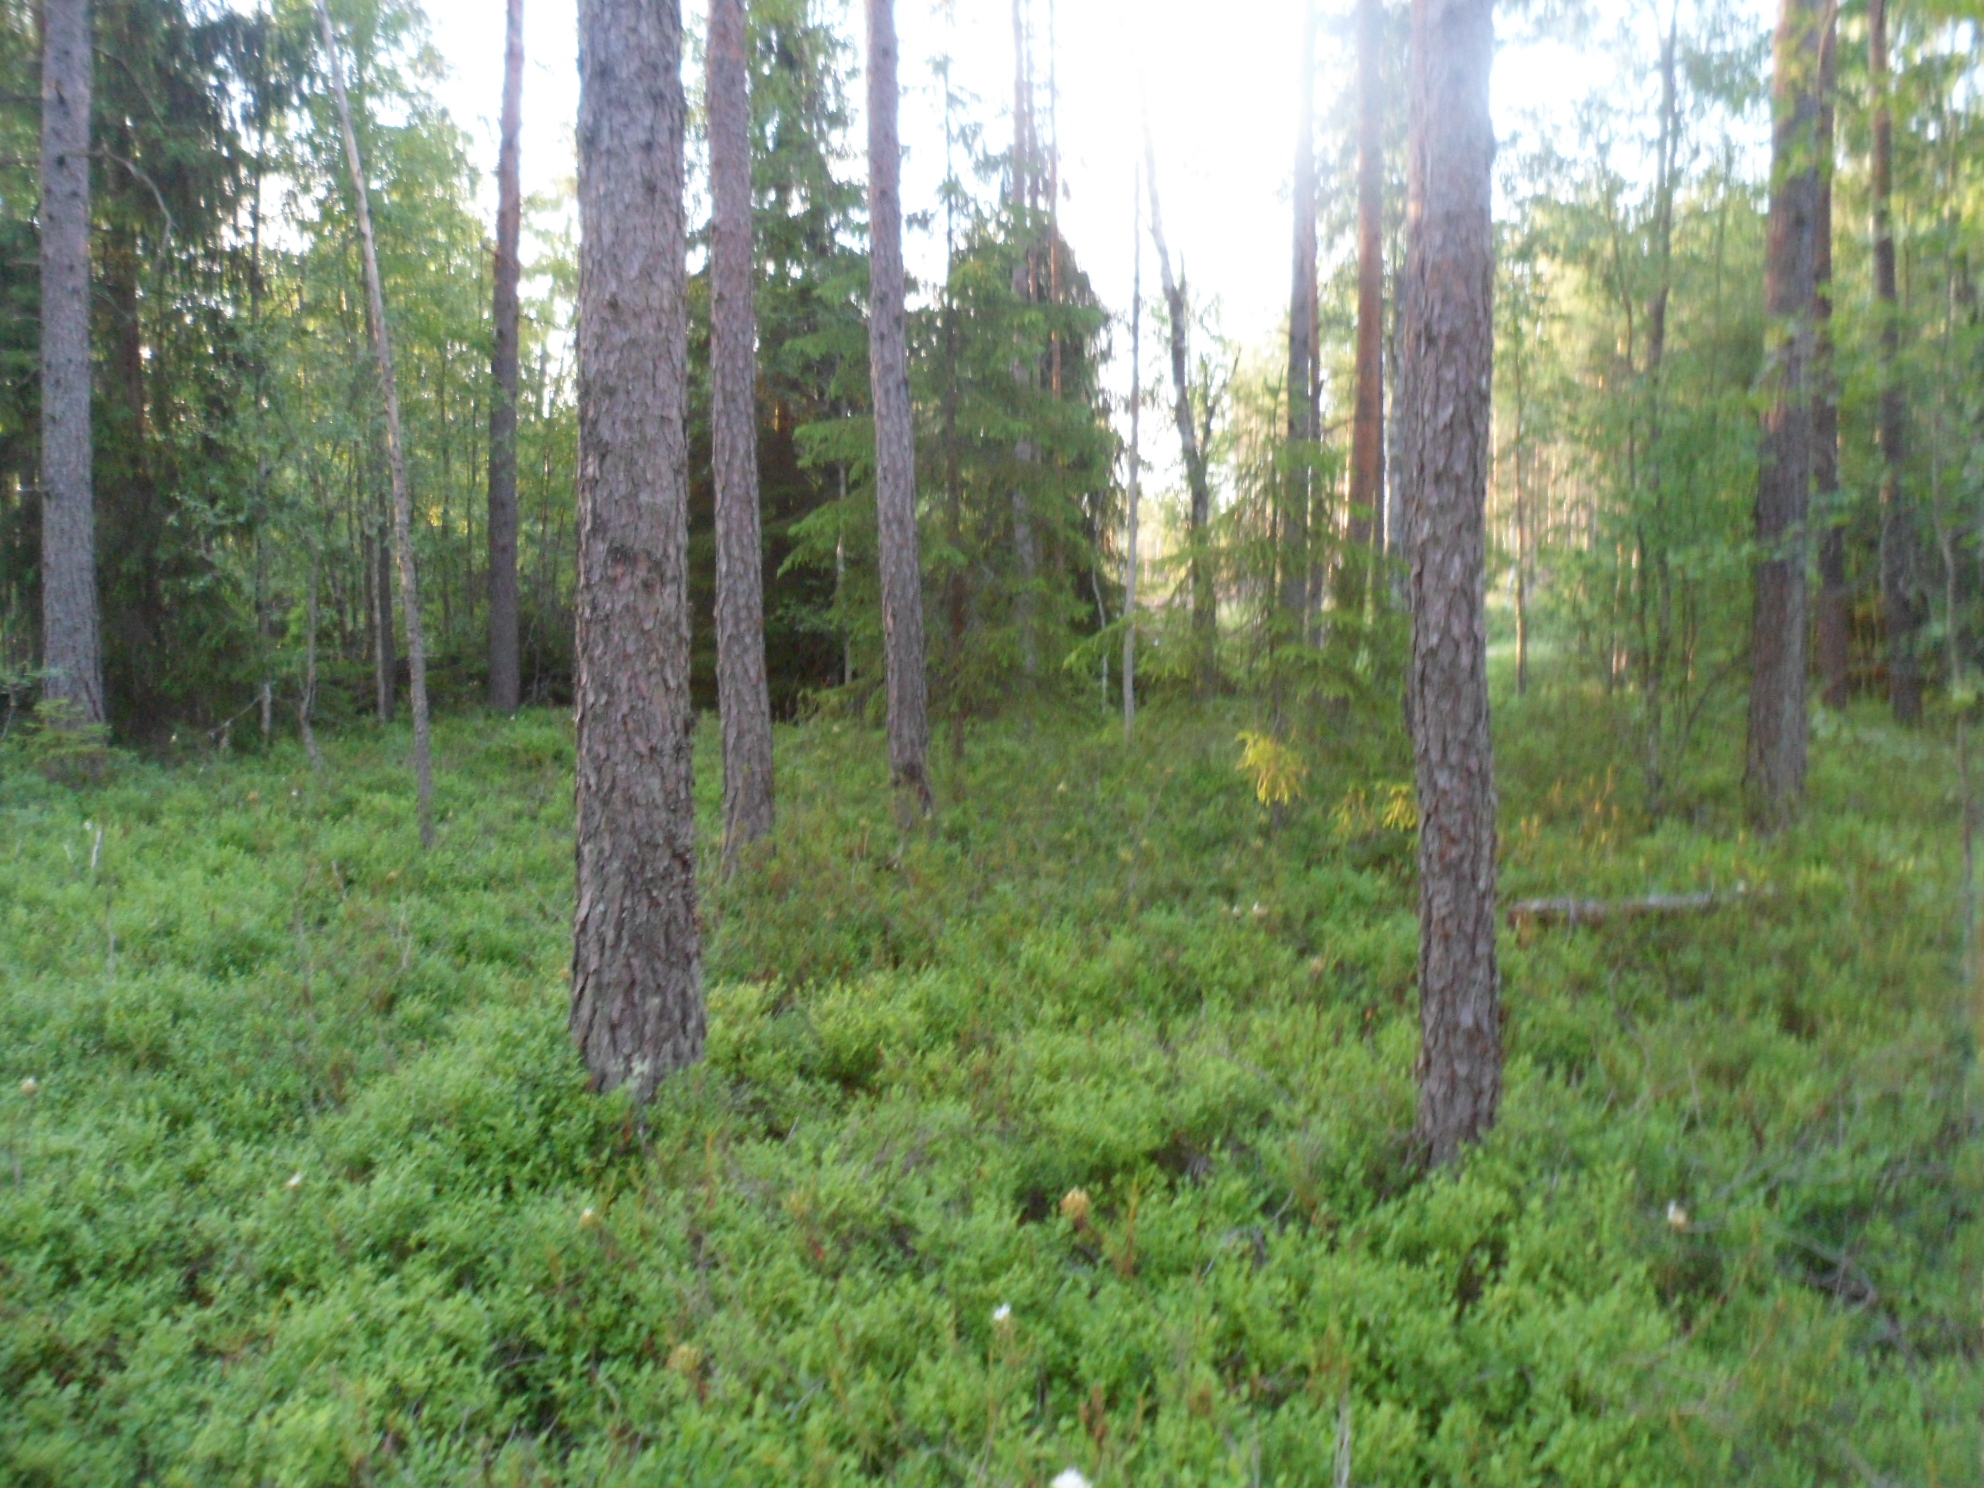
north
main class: Woodland
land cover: Pine dominated coniferous woodland
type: boreal forest
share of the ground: 50 - 75 %
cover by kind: coniferous forest trees 50 %, shrubs 35 %, broadleaved forest trees 5 %, herbaceous plants 5 %, lichens and mosses 5 %
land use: Forestry
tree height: > 5 m
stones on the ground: < 10 %
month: July
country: SE
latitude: 57.1935
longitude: 14.3816
